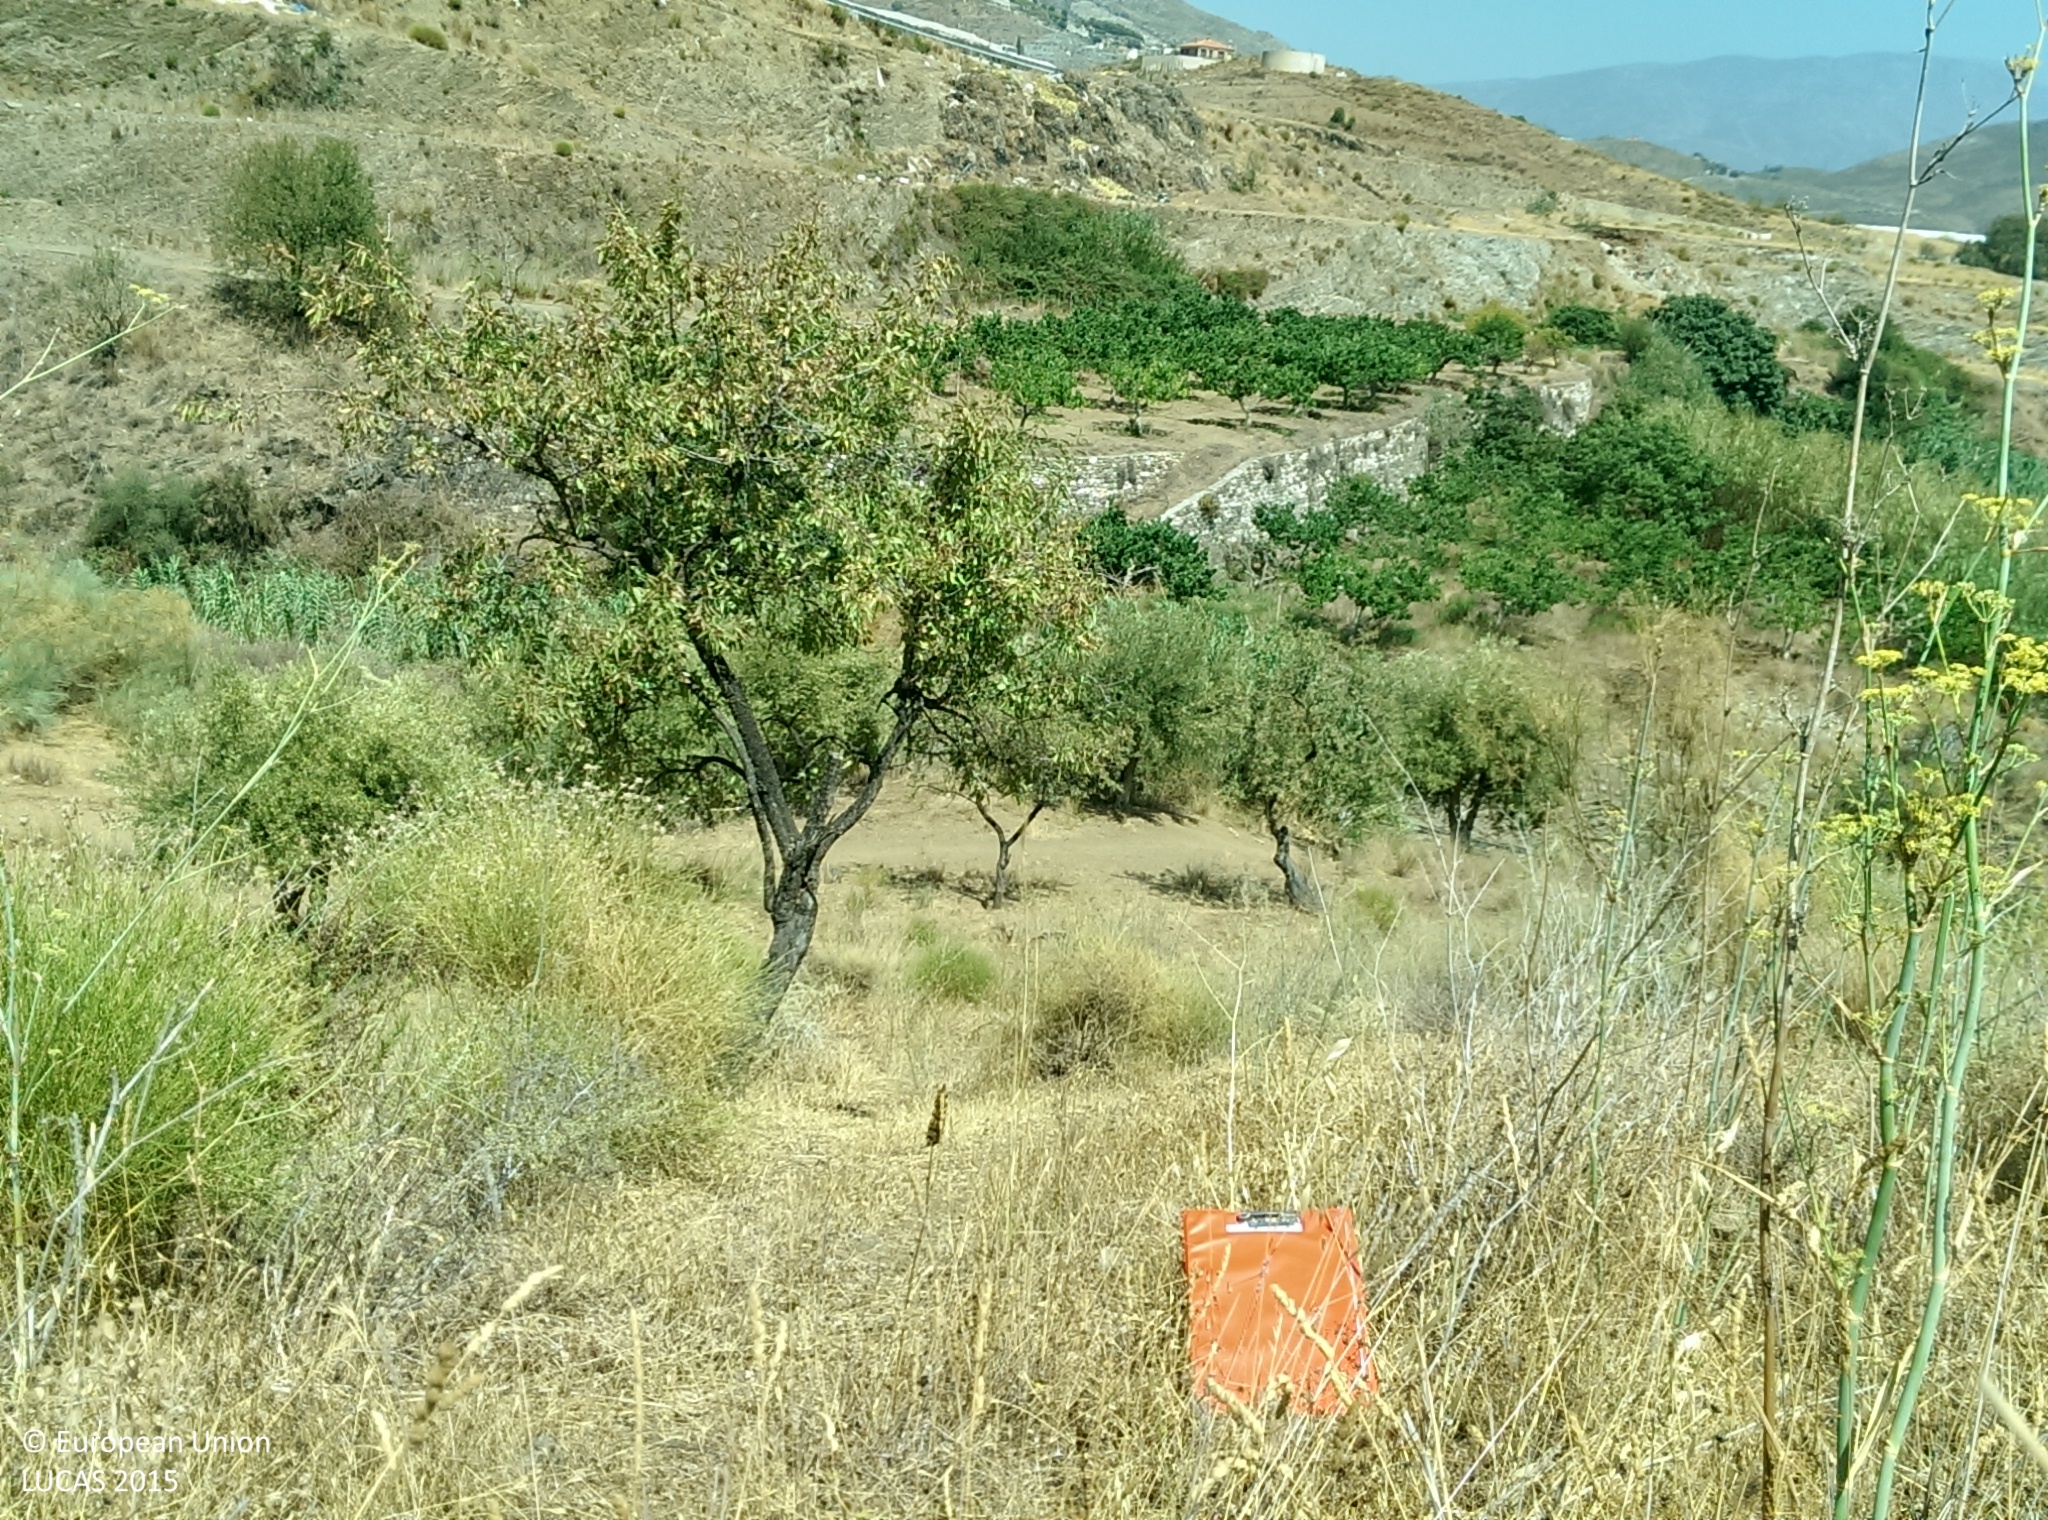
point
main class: Cropland
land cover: Nuts trees
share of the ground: 10 - 25 %
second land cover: Spontaneously vegetated surfaces
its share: 50 - 75 %
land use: Agriculture (excluding fallow land and kitchen gardens)
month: August
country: ES
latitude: 36.7811
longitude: -3.6194
